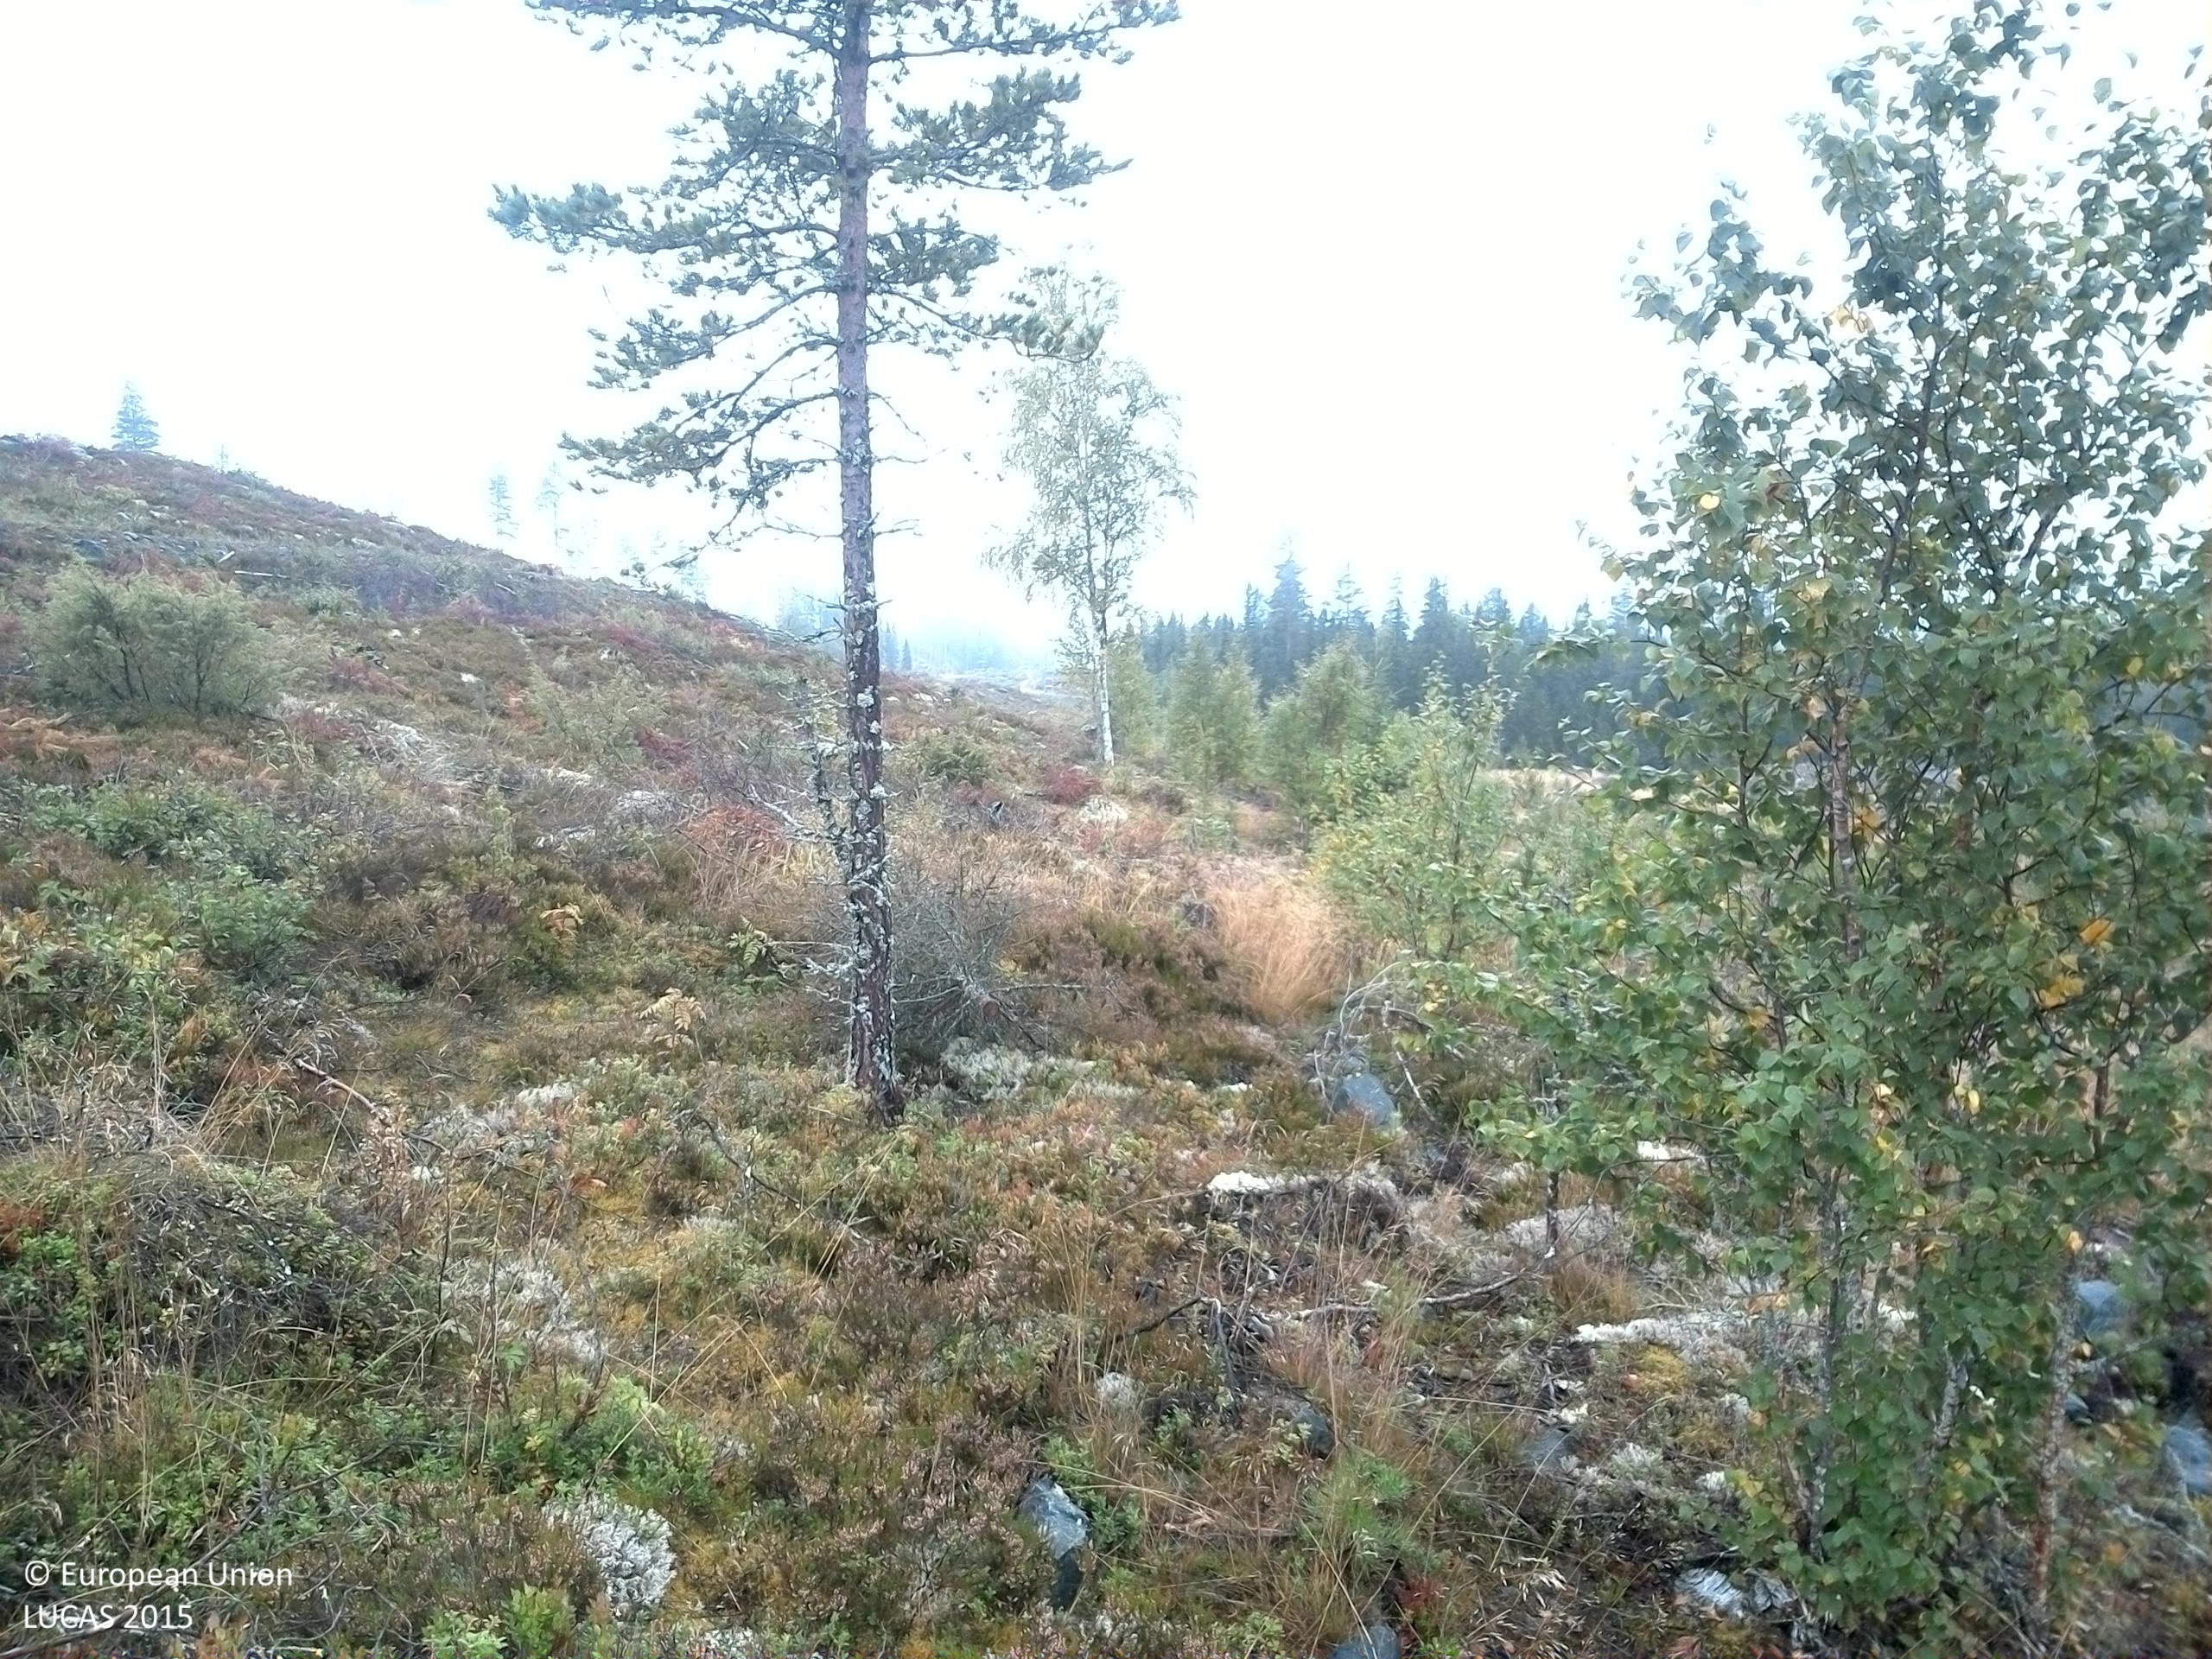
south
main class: Shrubland
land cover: Shrubland with sparse tree cover
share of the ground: > 75 %
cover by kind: shrubs 70 %, lichens and mosses 10 %, consolidated bare surface 10 %, coniferous forest trees 5 %, herbaceous plants 5 %
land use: Forestry
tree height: < 5 m
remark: Clear cut
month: September
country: SE
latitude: 61.6742
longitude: 15.1789
